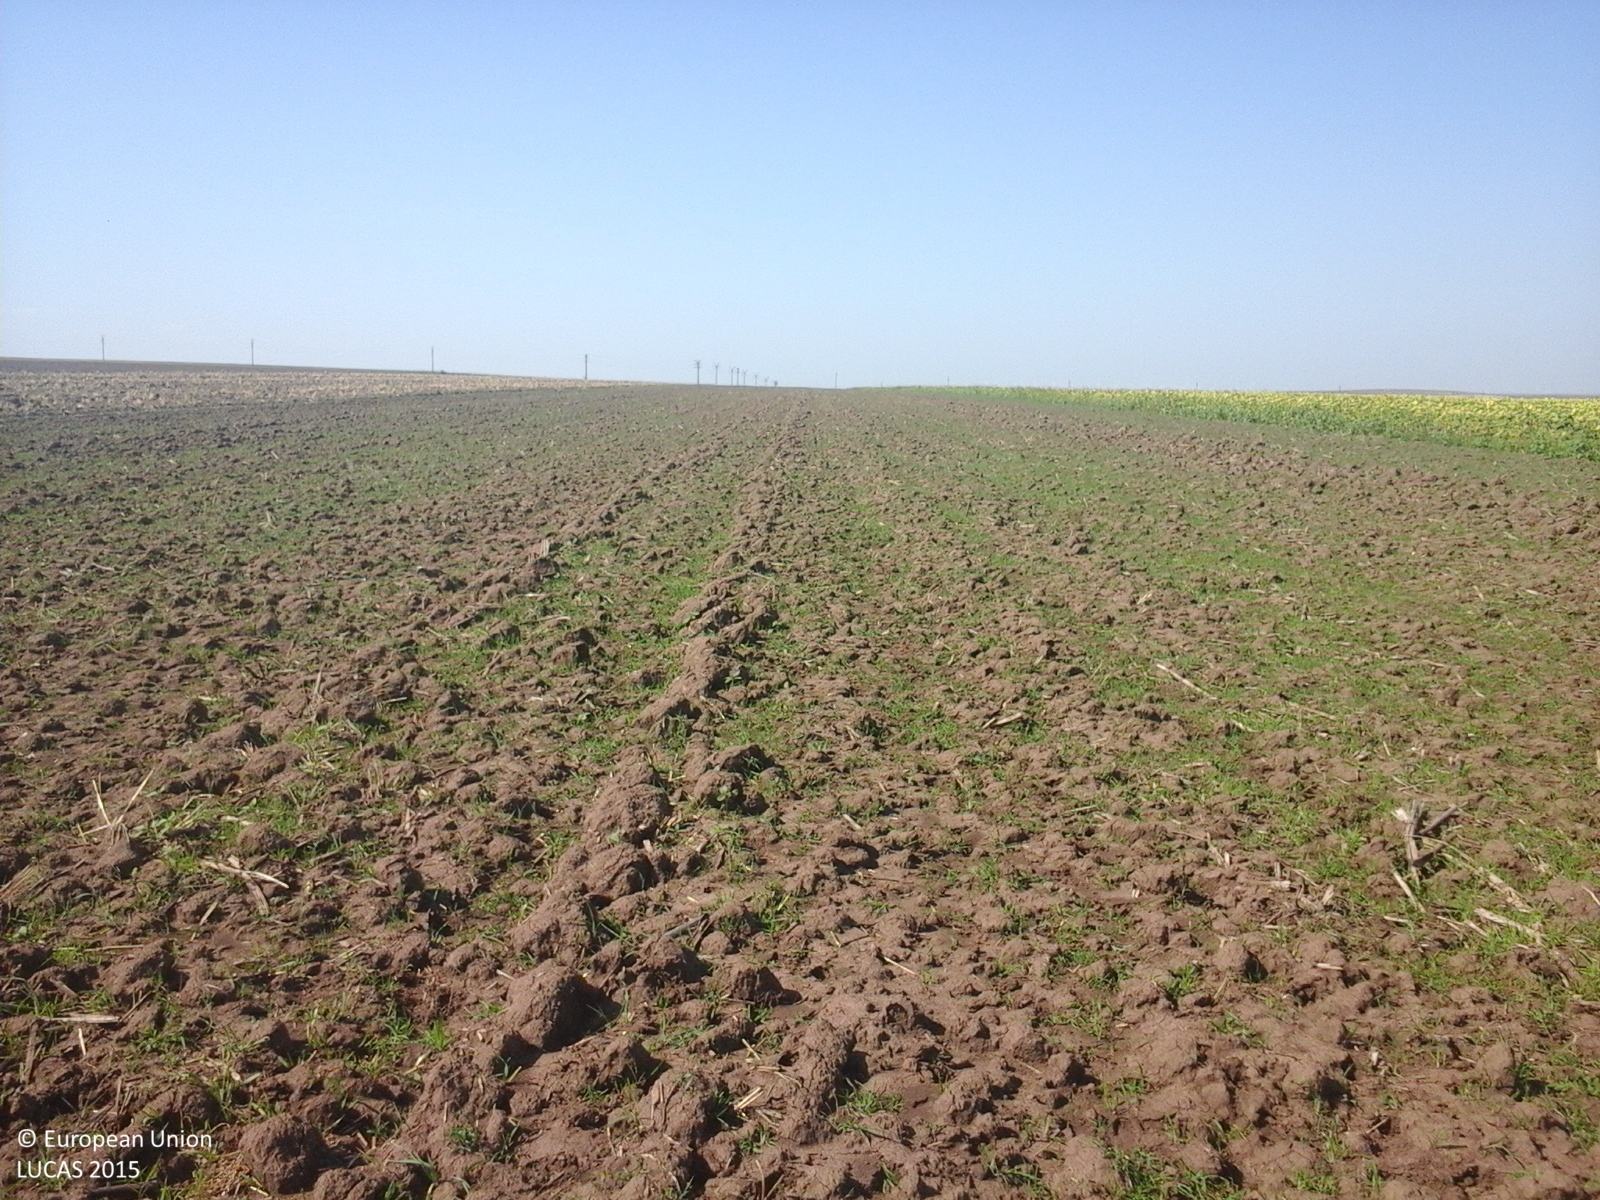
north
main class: Cropland
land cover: Durum wheat
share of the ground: 10 - 25 %
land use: Agriculture (excluding fallow land and kitchen gardens)
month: August
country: RO
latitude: 44.3889
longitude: 28.4870
